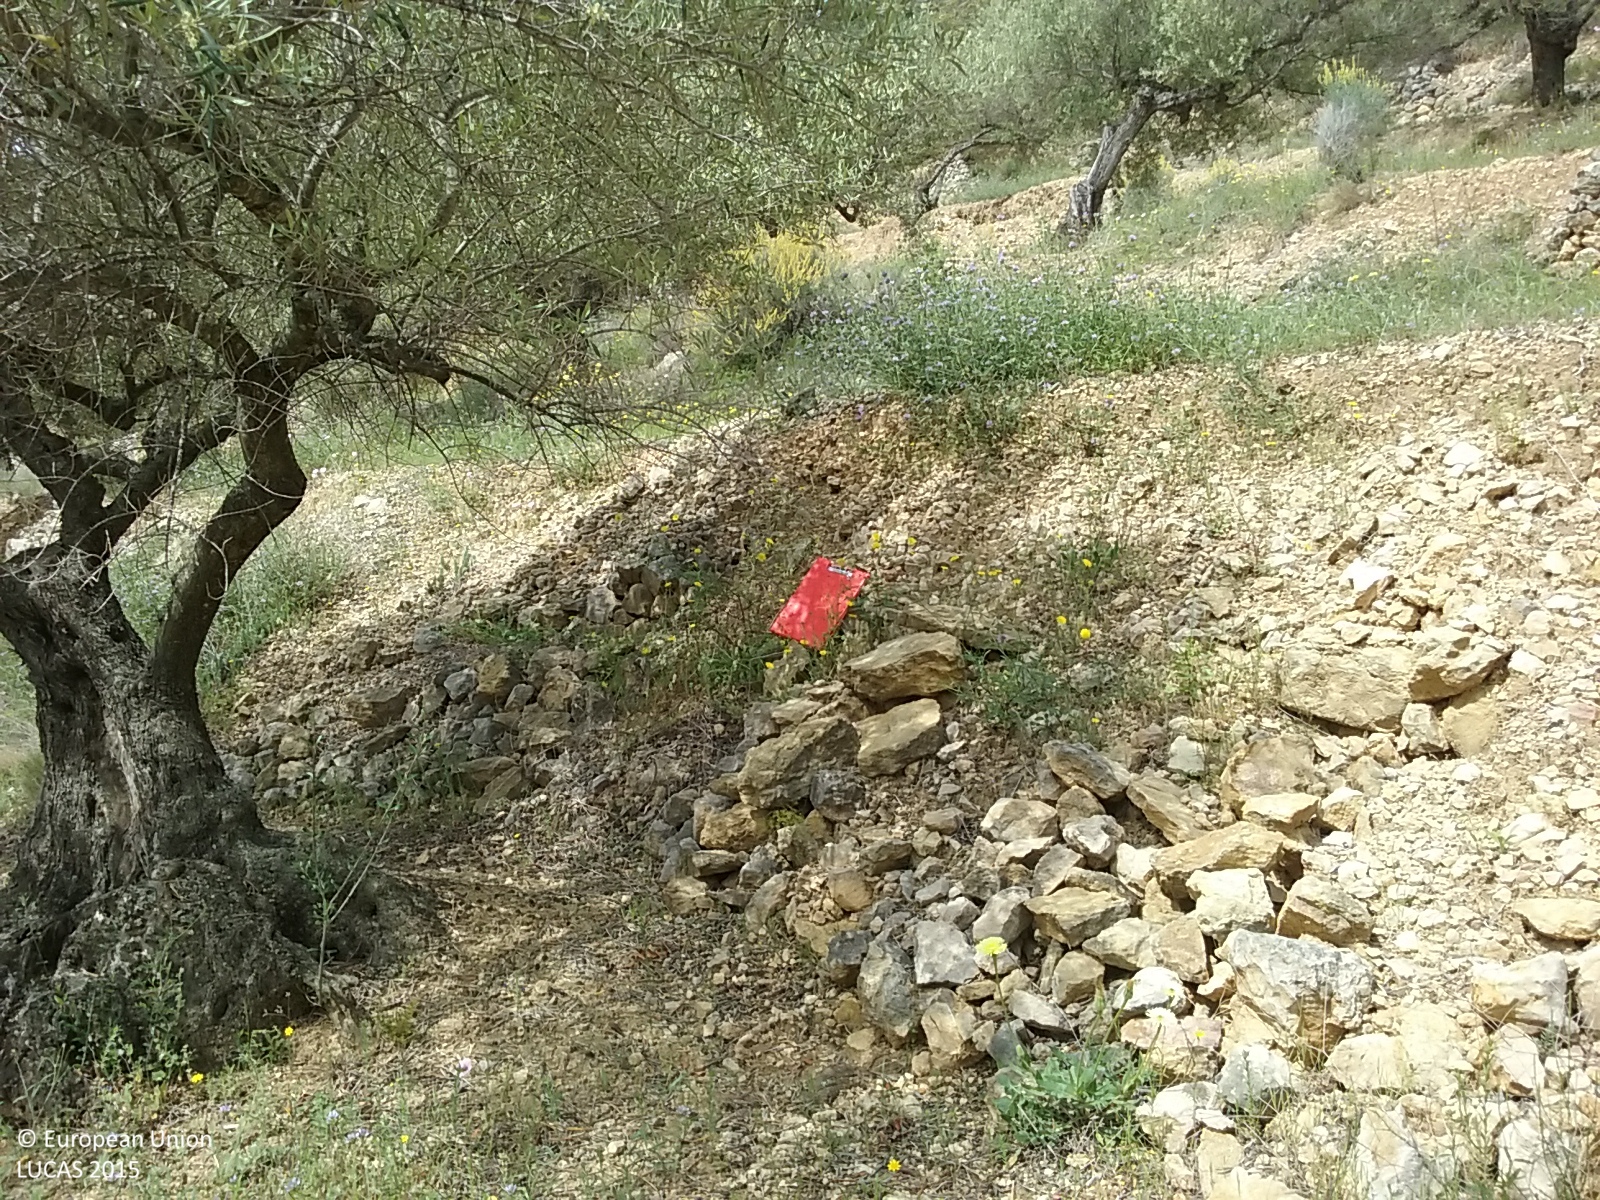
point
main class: Cropland
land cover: Olive groves
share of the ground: 50 - 75 %
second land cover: Spontaneously vegetated surfaces
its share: 50 - 75 %
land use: Agriculture (excluding fallow land and kitchen gardens)
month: May
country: ES
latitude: 40.7772
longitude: 0.5746
